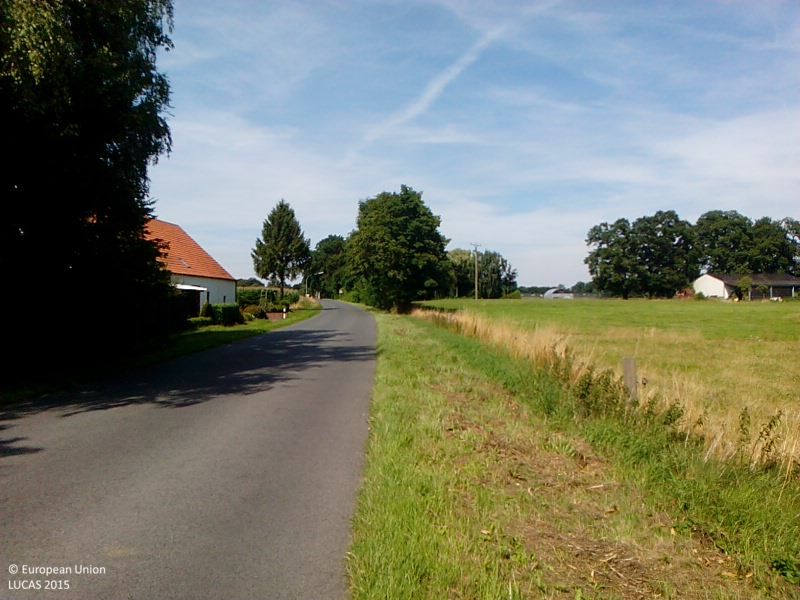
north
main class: Grassland
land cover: Grassland without tree/shrub cover
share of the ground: > 75 %
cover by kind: herbaceous plants 100 %
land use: Agriculture (excluding fallow land and kitchen gardens)
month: August
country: DE
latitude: 52.3502
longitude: 8.5177
